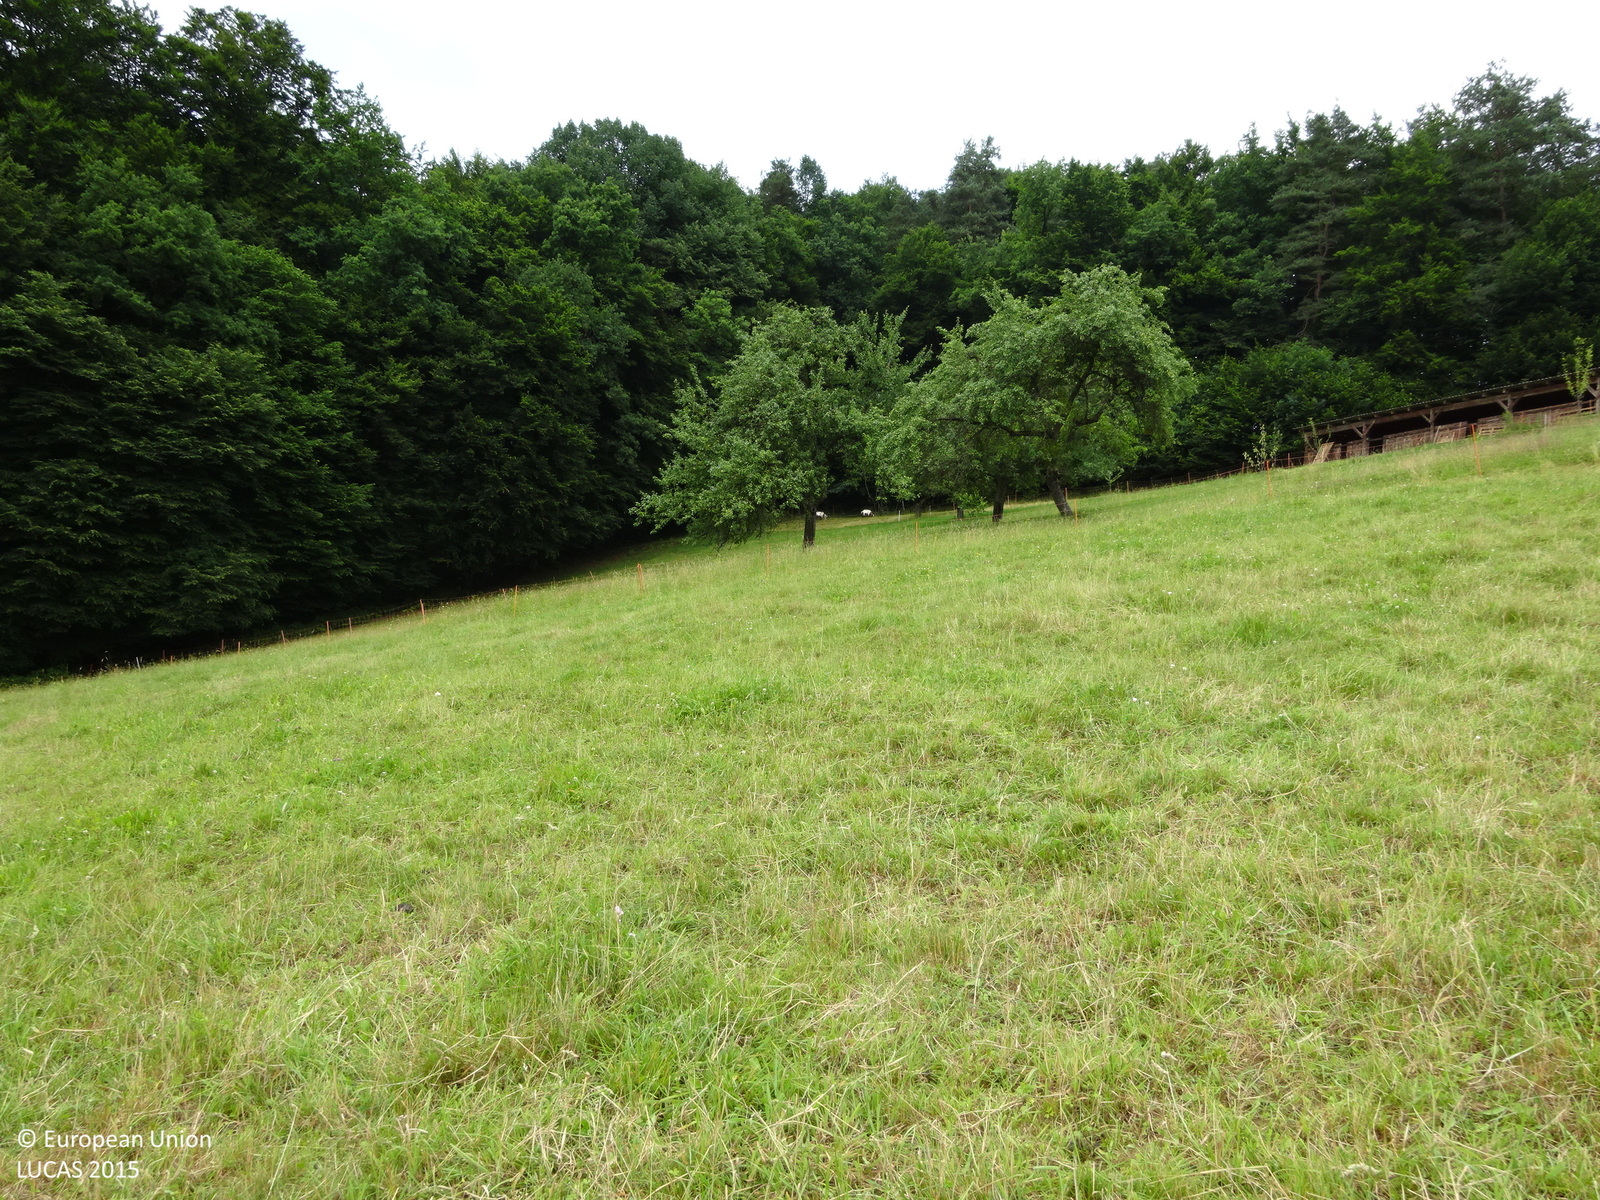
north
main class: Grassland
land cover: Grassland without tree/shrub cover
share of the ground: > 75 %
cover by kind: herbaceous plants 100 %
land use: Agriculture (excluding fallow land and kitchen gardens)
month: June
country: AT
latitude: 46.7034
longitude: 15.3744
